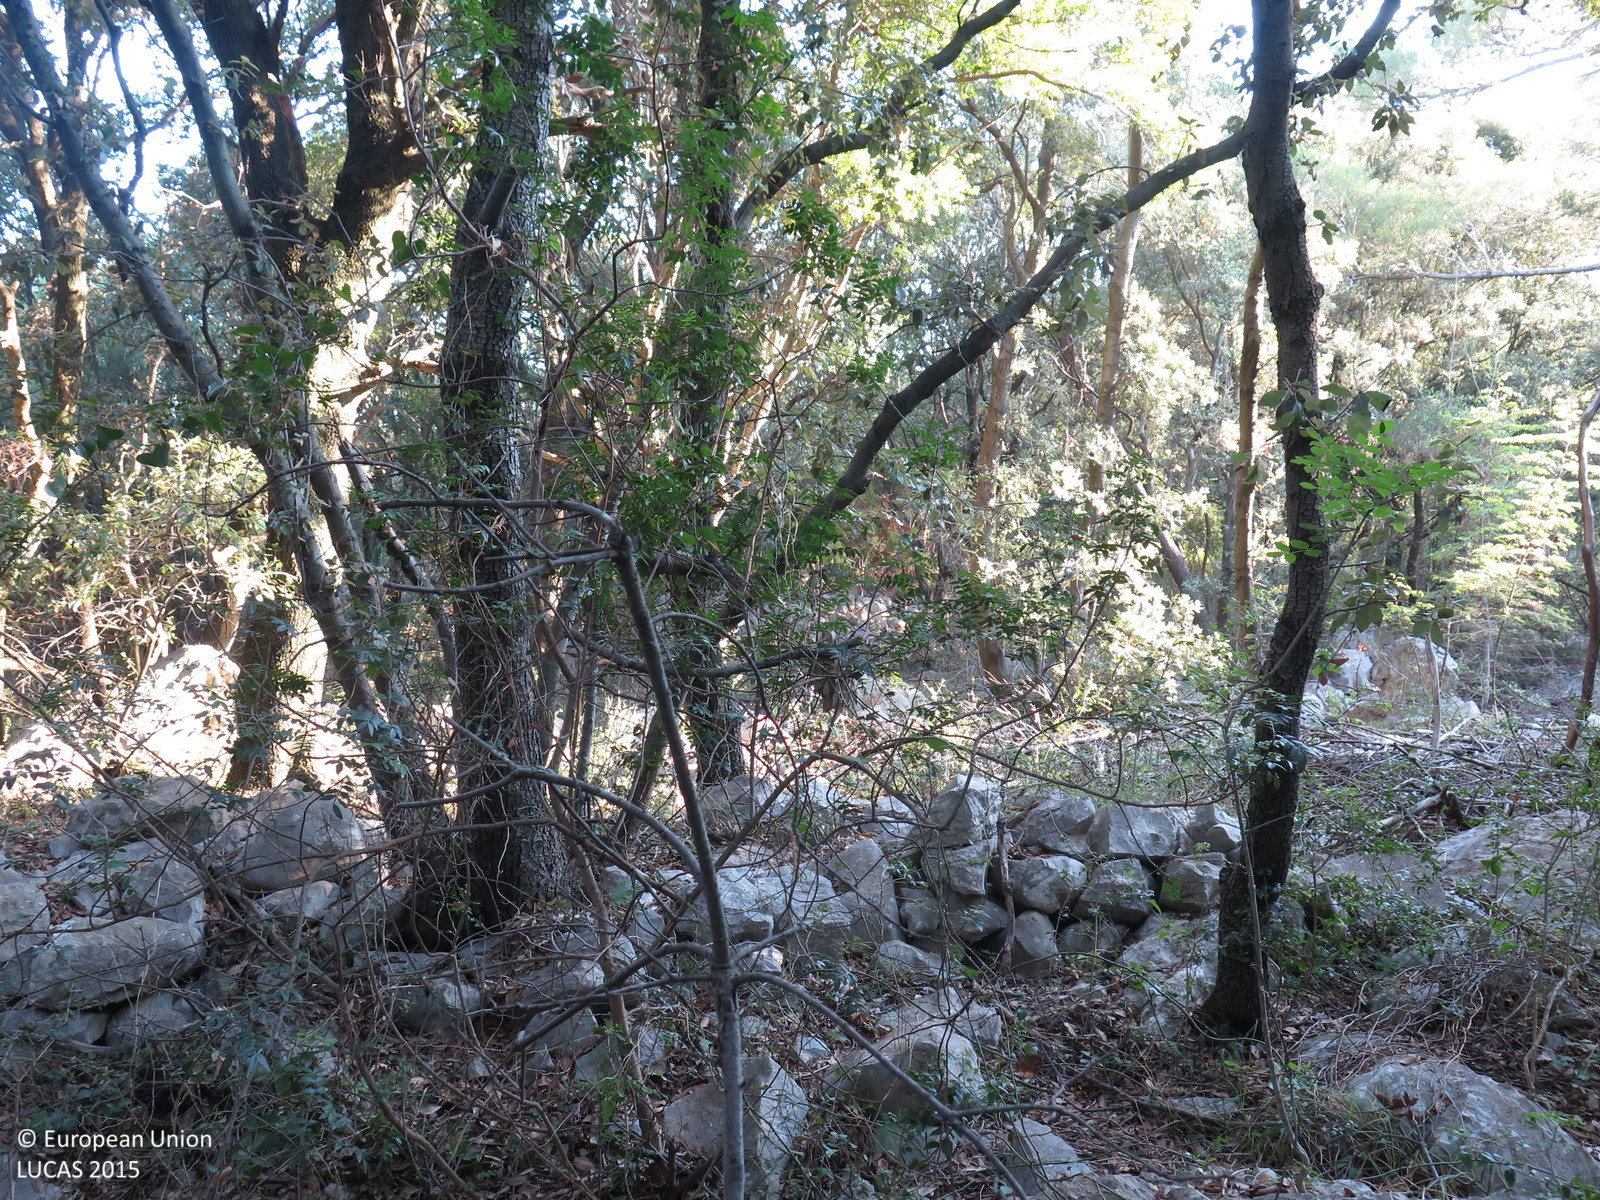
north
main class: Woodland
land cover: Broadleaved woodland
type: thermophilous deciduous forest
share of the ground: > 75 %
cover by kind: broadleaved forest trees 90 %, shrubs 5 %, unconsolidated bare surface 5 %
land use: Forestry
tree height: > 5 m
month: August
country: HR
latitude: 44.7676
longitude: 14.7065
